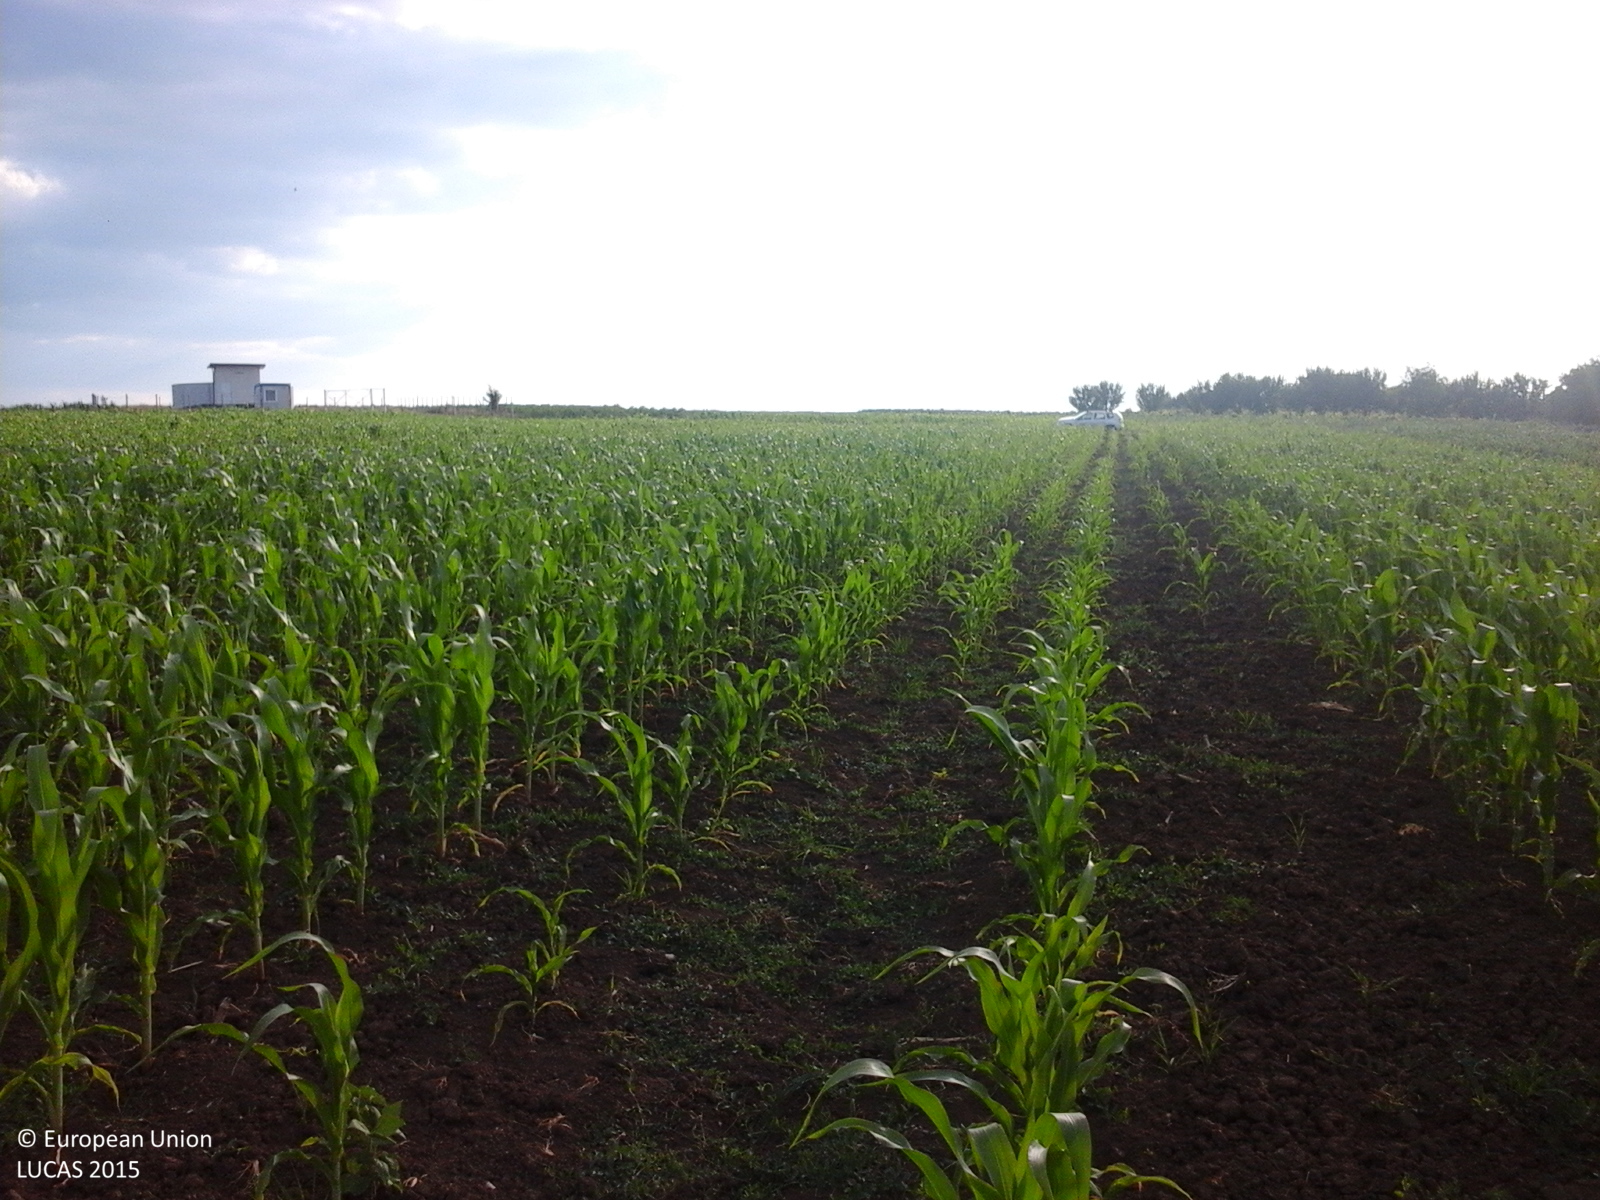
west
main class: Cropland
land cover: Maize
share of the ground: 50 - 75 %
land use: Agriculture (excluding fallow land and kitchen gardens)
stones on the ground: < 10 %
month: June
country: RO
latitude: 47.1511
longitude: 27.3210
